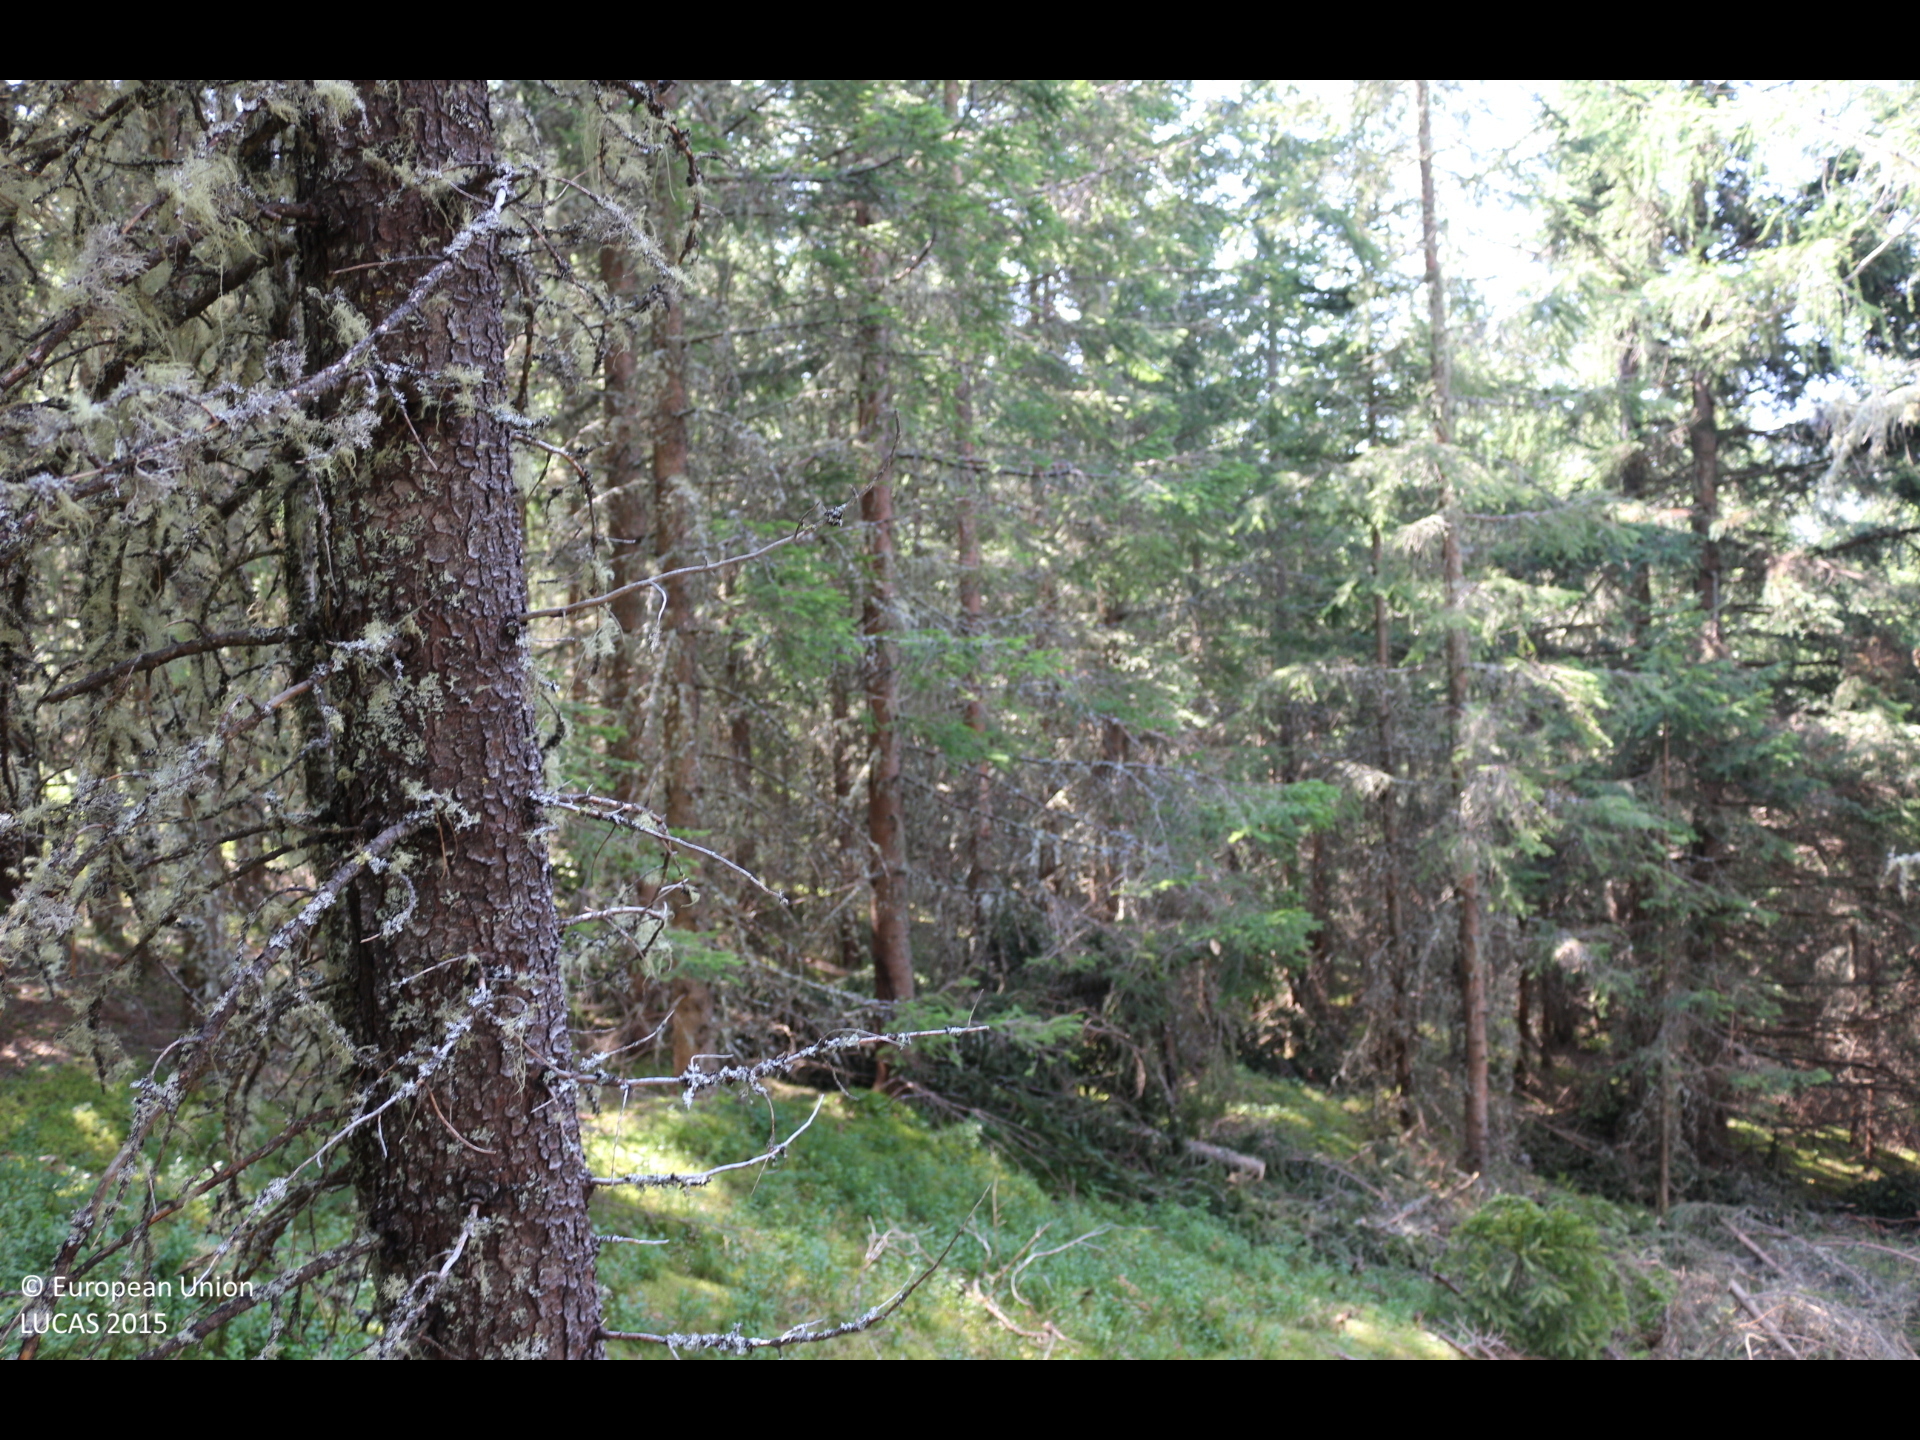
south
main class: Woodland
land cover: Spruce dominated coniferous woodland
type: alpine coniferous forest
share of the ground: > 75 %
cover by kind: coniferous forest trees 90 %, herbaceous plants 10 %
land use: Forestry
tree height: > 5 m
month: August
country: AT
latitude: 46.8715
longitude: 13.9992
